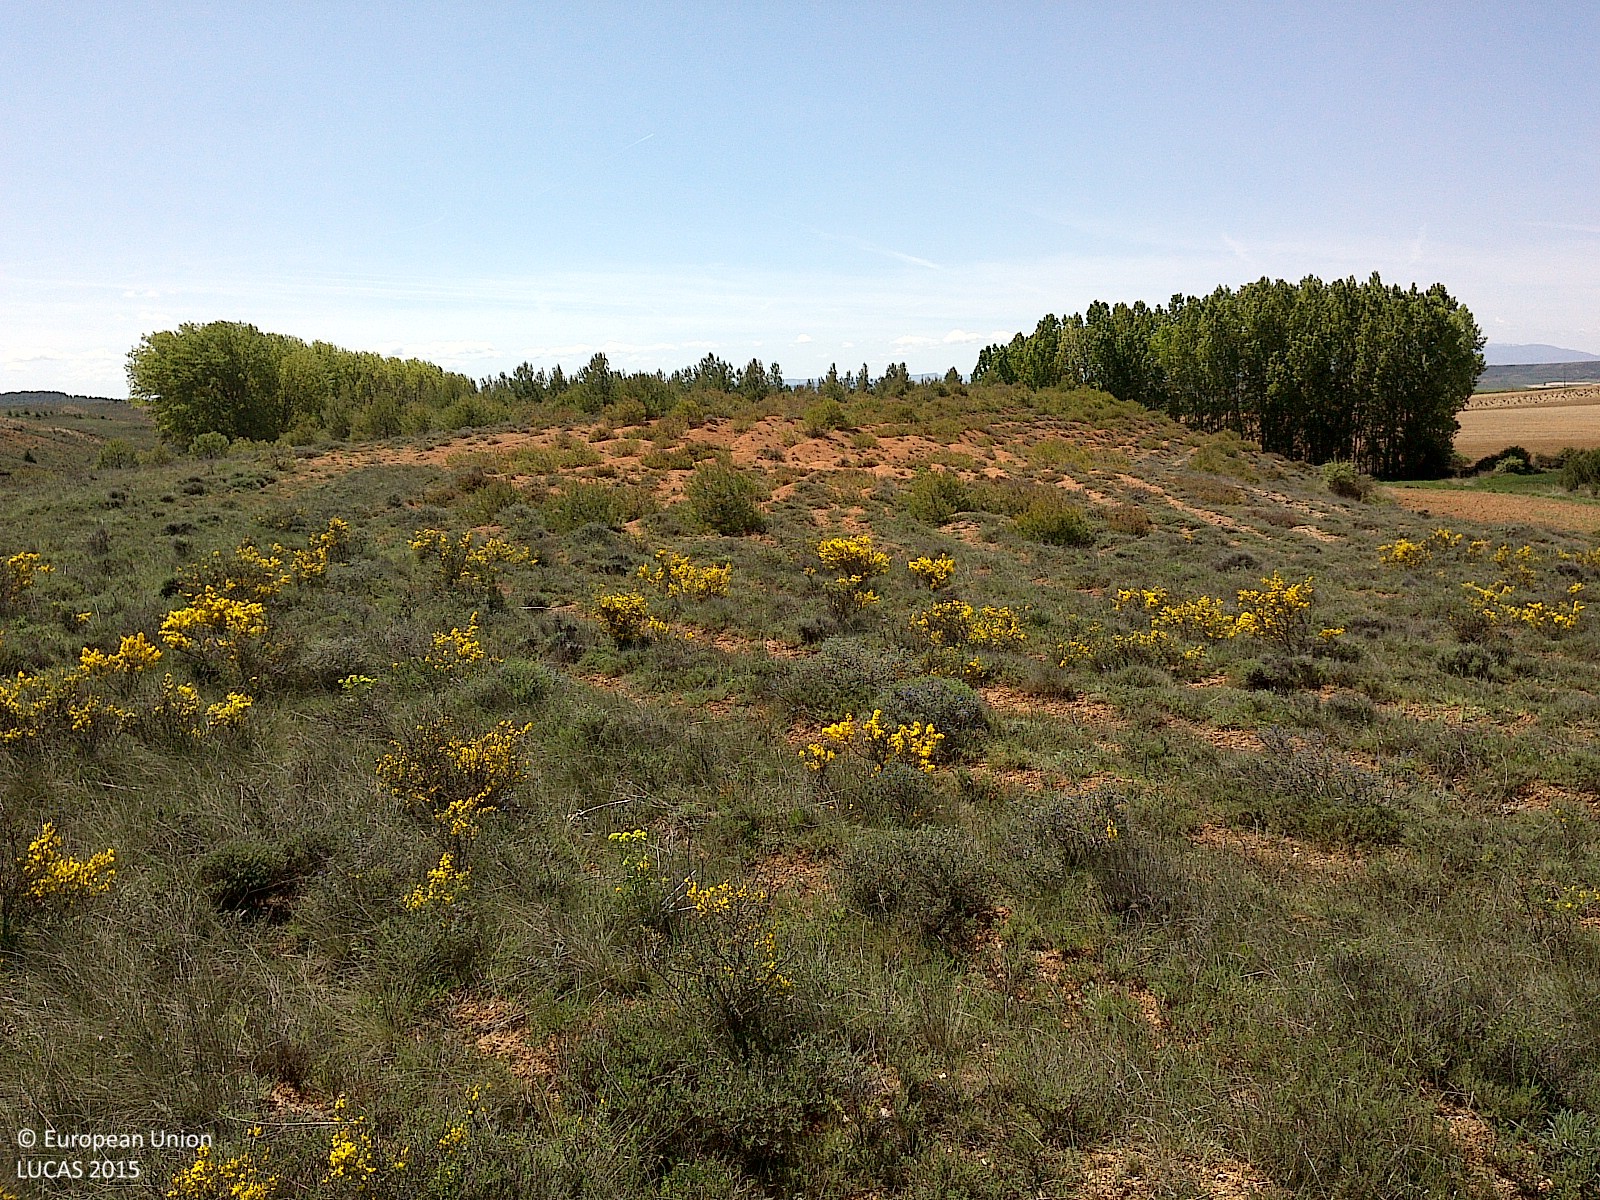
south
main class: Shrubland
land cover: Shrubland with sparse tree cover
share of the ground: 50 - 75 %
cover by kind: shrubs 65 %, herbaceous plants 20 %, unconsolidated bare surface 10 %, coniferous forest trees 5 %
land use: Semi-natural and natural areas not in use
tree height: < 5 m
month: May
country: ES
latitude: 41.6021
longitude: -3.2075
